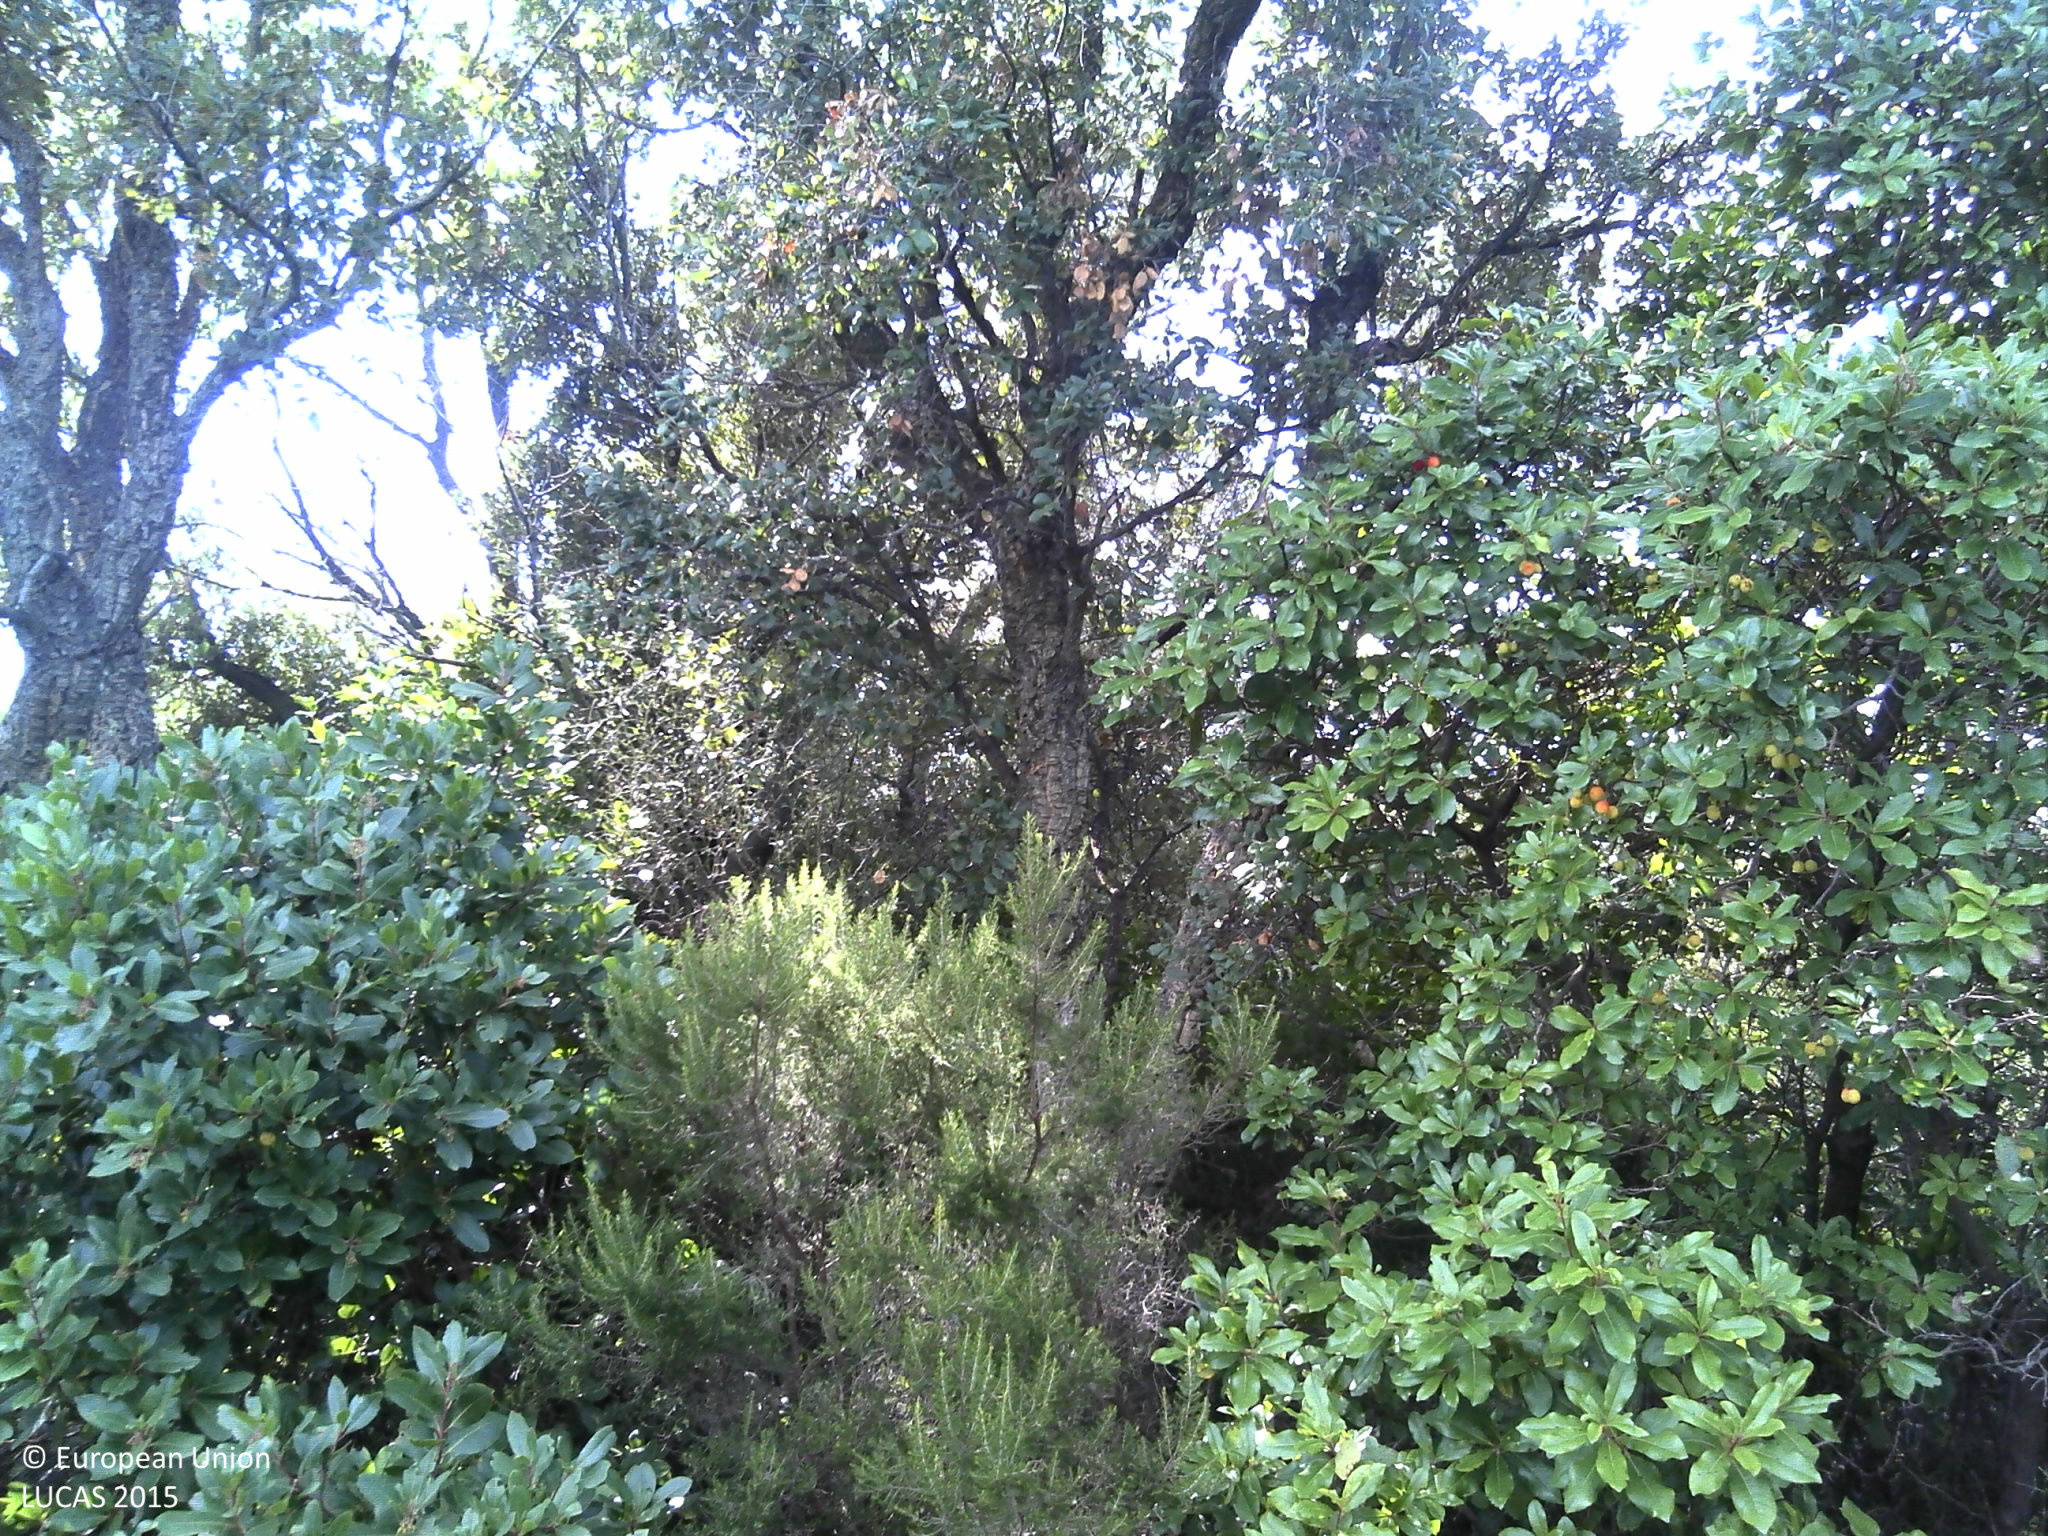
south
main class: Woodland
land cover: Broadleaved woodland
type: broadleaved evergreen forest
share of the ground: > 75 %
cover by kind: broadleaved forest trees 80 %, shrubs 20 %
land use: Semi-natural and natural areas not in use
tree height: > 5 m
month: October
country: FR
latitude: 43.1925
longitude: 6.5759
